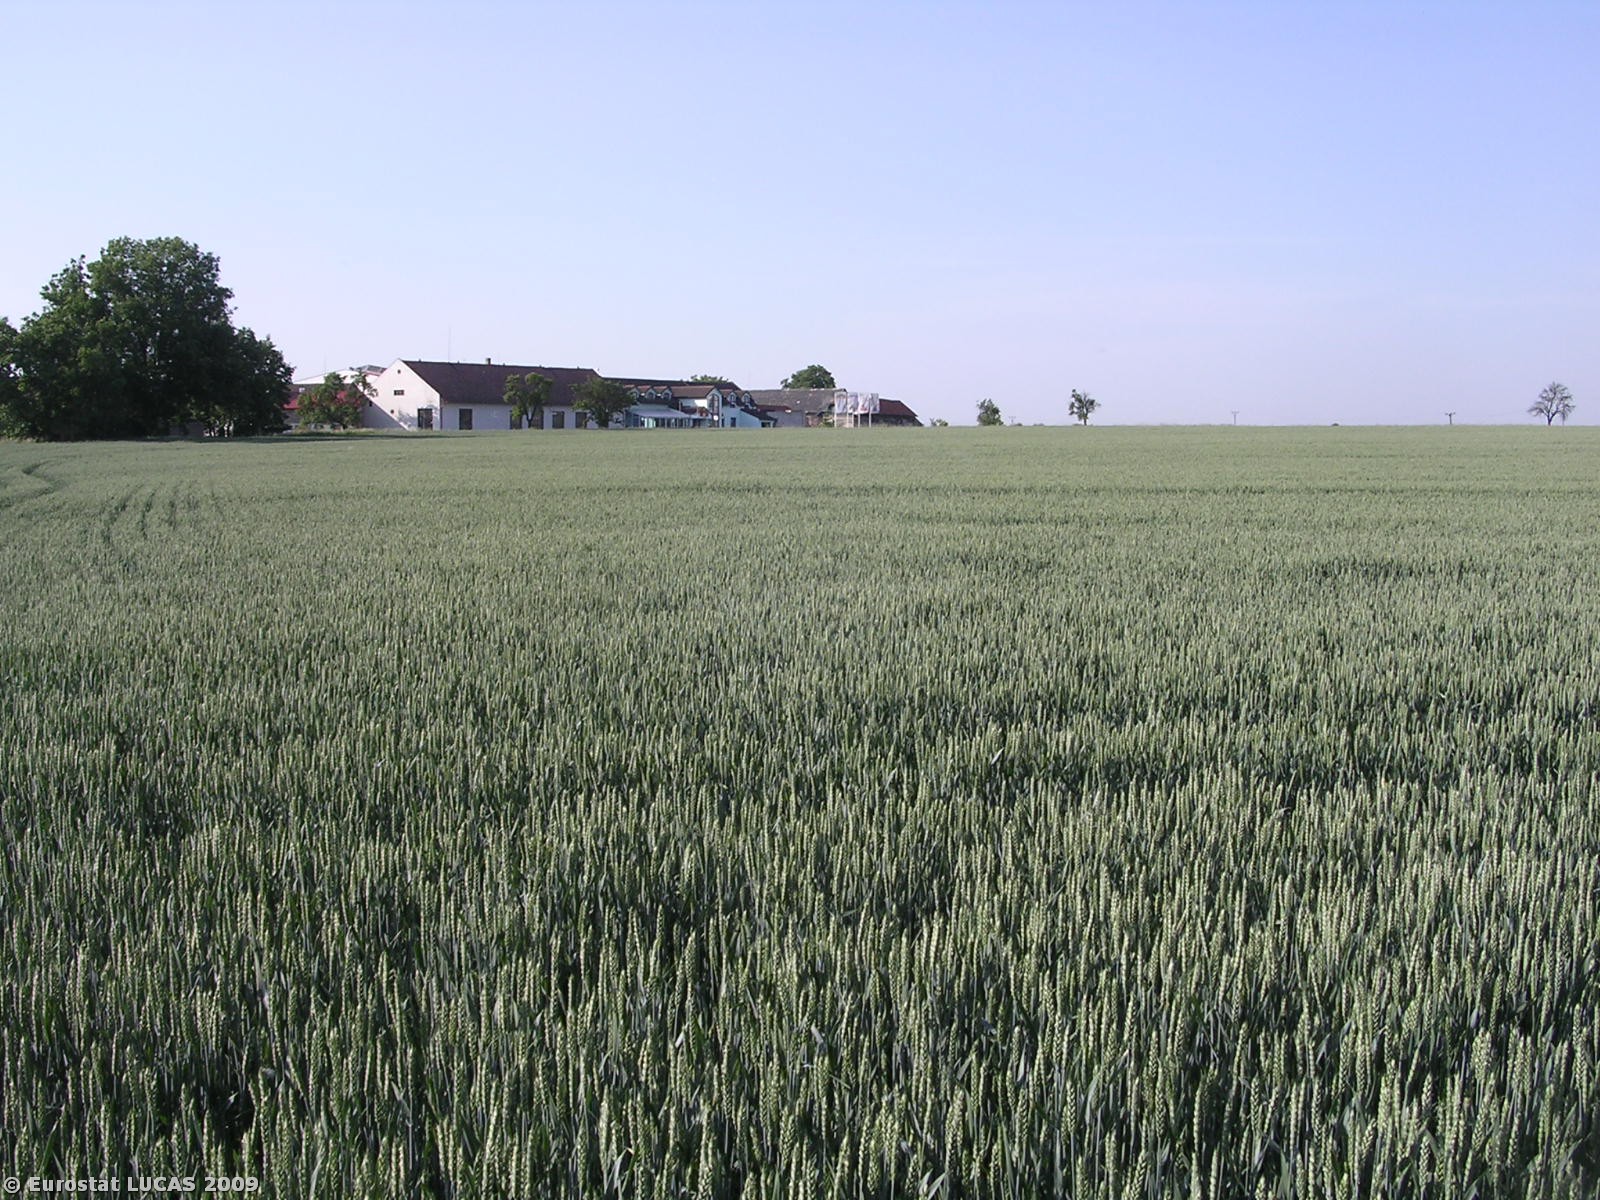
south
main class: Cropland
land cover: Common wheat
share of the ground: > 75 %
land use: Agriculture (excluding fallow land and kitchen gardens)
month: May
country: CZ
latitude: 50.3106
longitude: 14.9596
